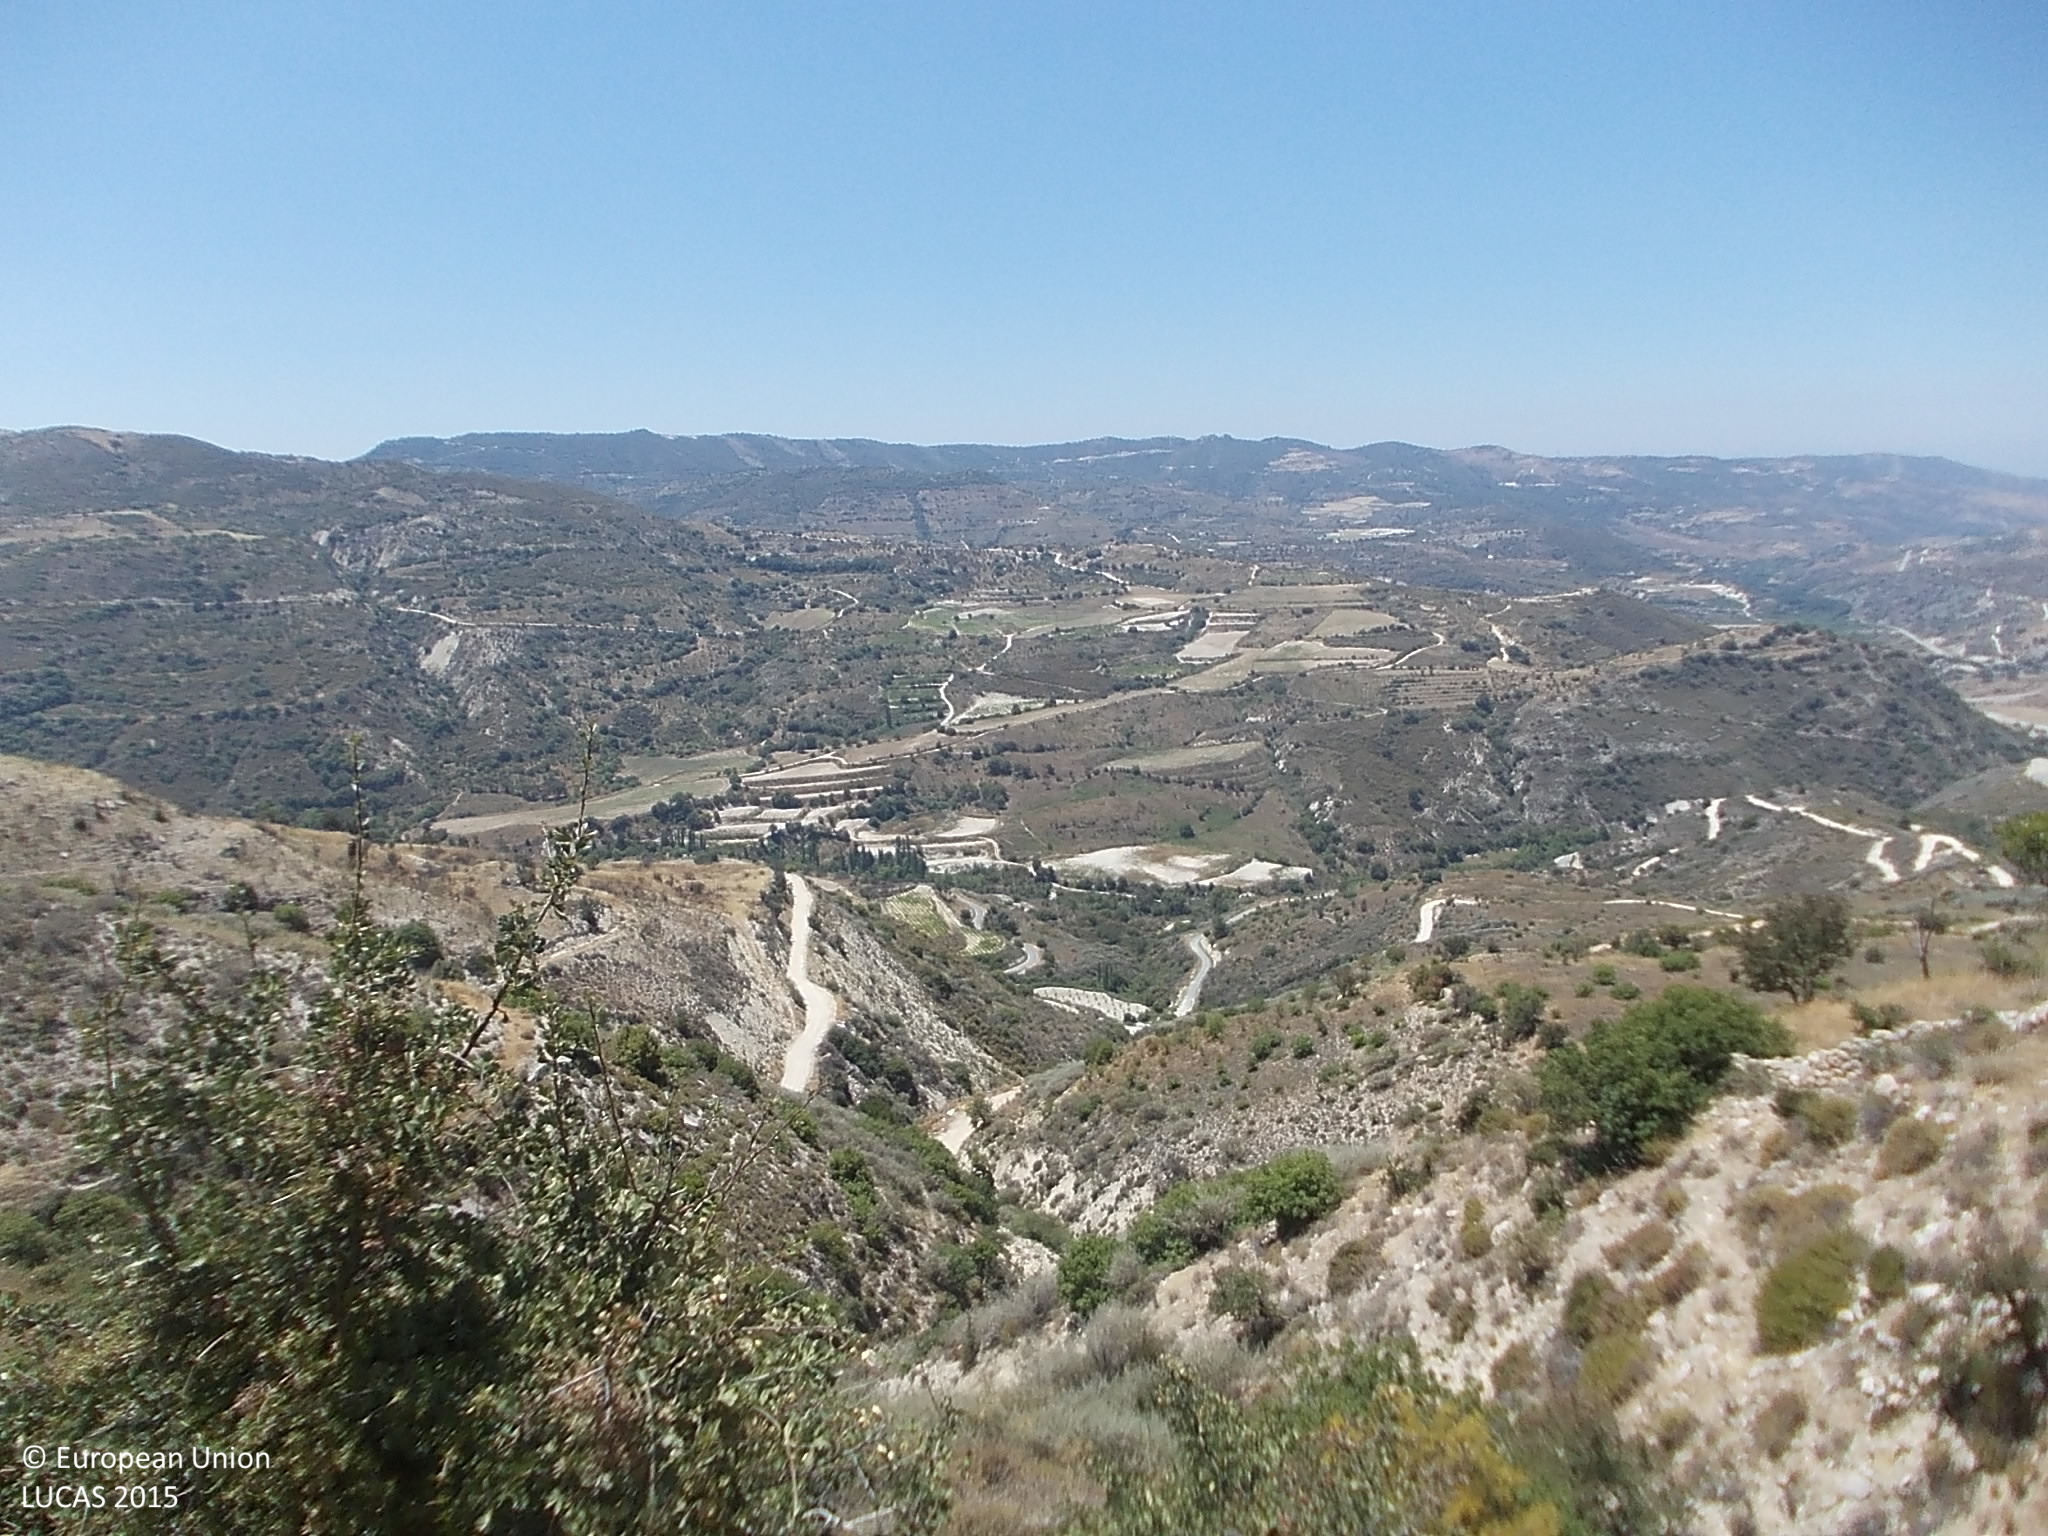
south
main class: Grassland
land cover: Grassland with sparse tree/shrub cover
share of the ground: > 75 %
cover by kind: herbaceous plants 75 %, unconsolidated bare surface 10 %, broadleaved forest trees 5 %, shrubs 5 %, consolidated bare surface 5 %
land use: Semi-natural and natural areas not in use
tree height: < 5 m
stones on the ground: 25 - 50 %
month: July
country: CY
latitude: 34.8238
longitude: 32.7353
